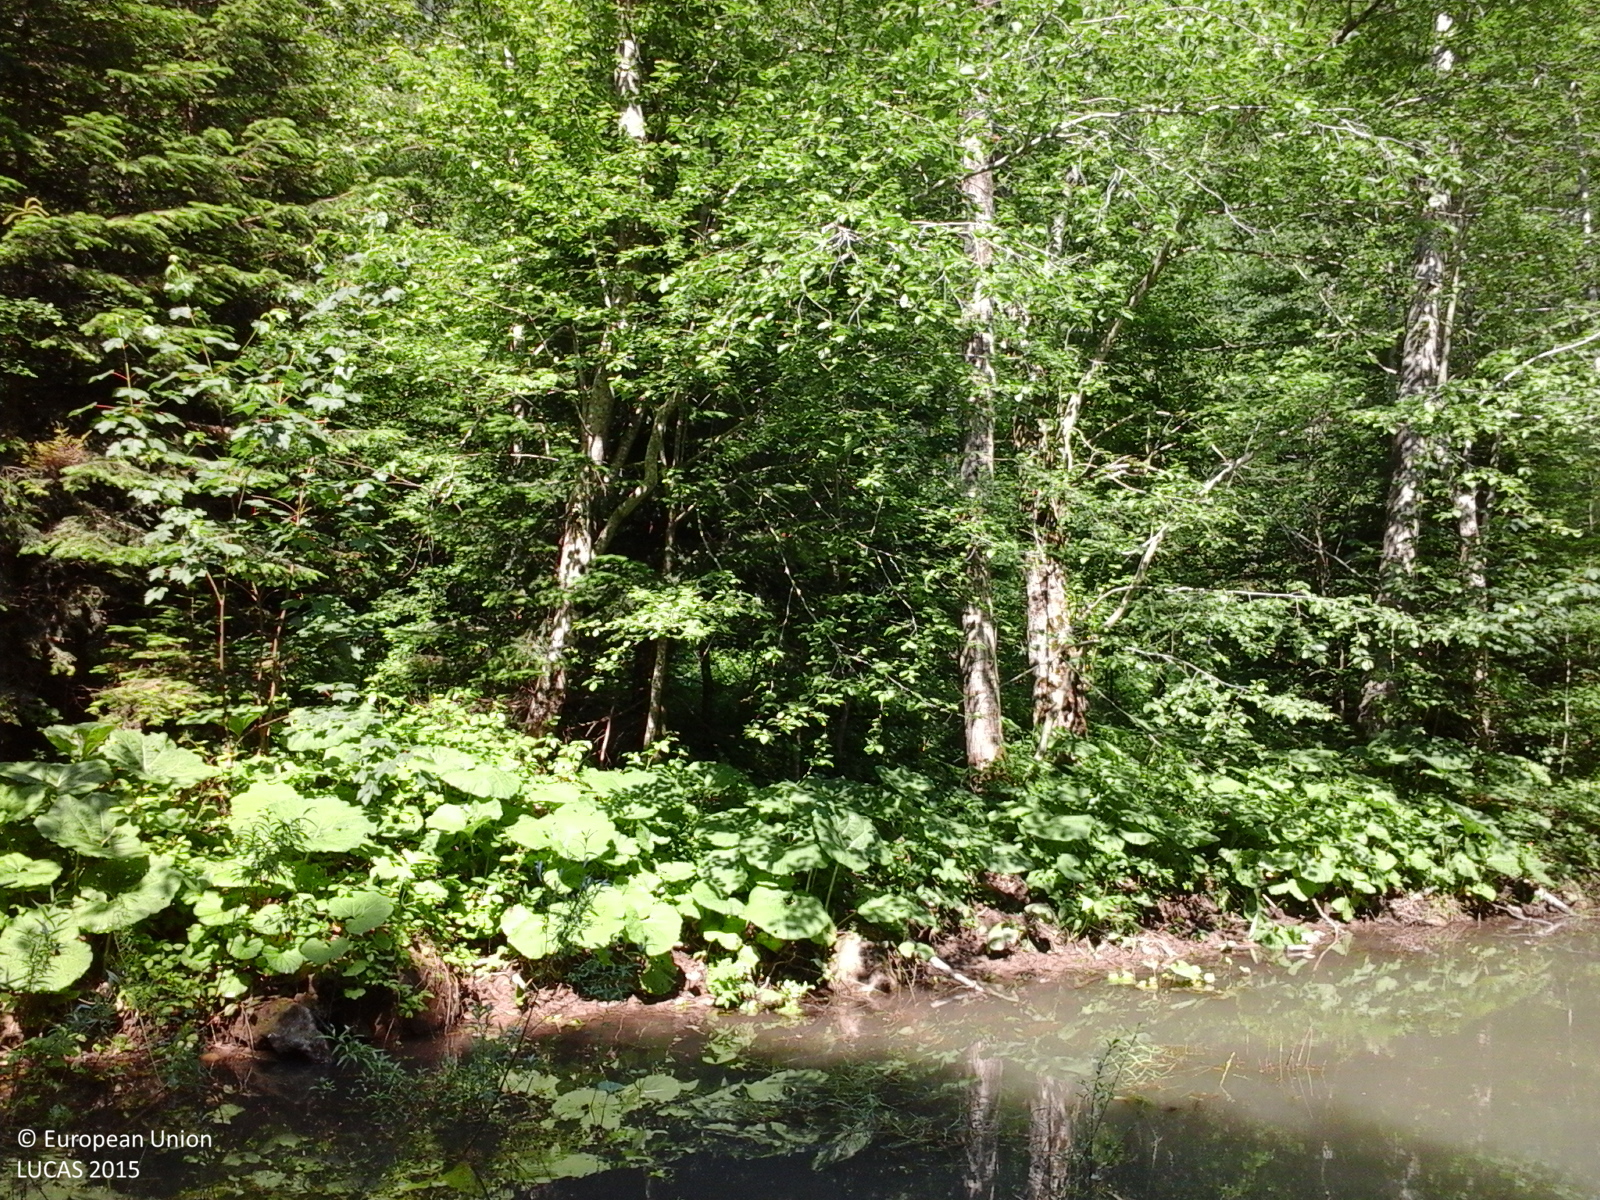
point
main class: Woodland
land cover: Broadleaved woodland
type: mountainous beech forest
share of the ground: > 75 %
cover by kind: broadleaved forest trees 100 %
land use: Forestry
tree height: > 5 m
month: June
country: RO
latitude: 46.2756
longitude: 26.4695
